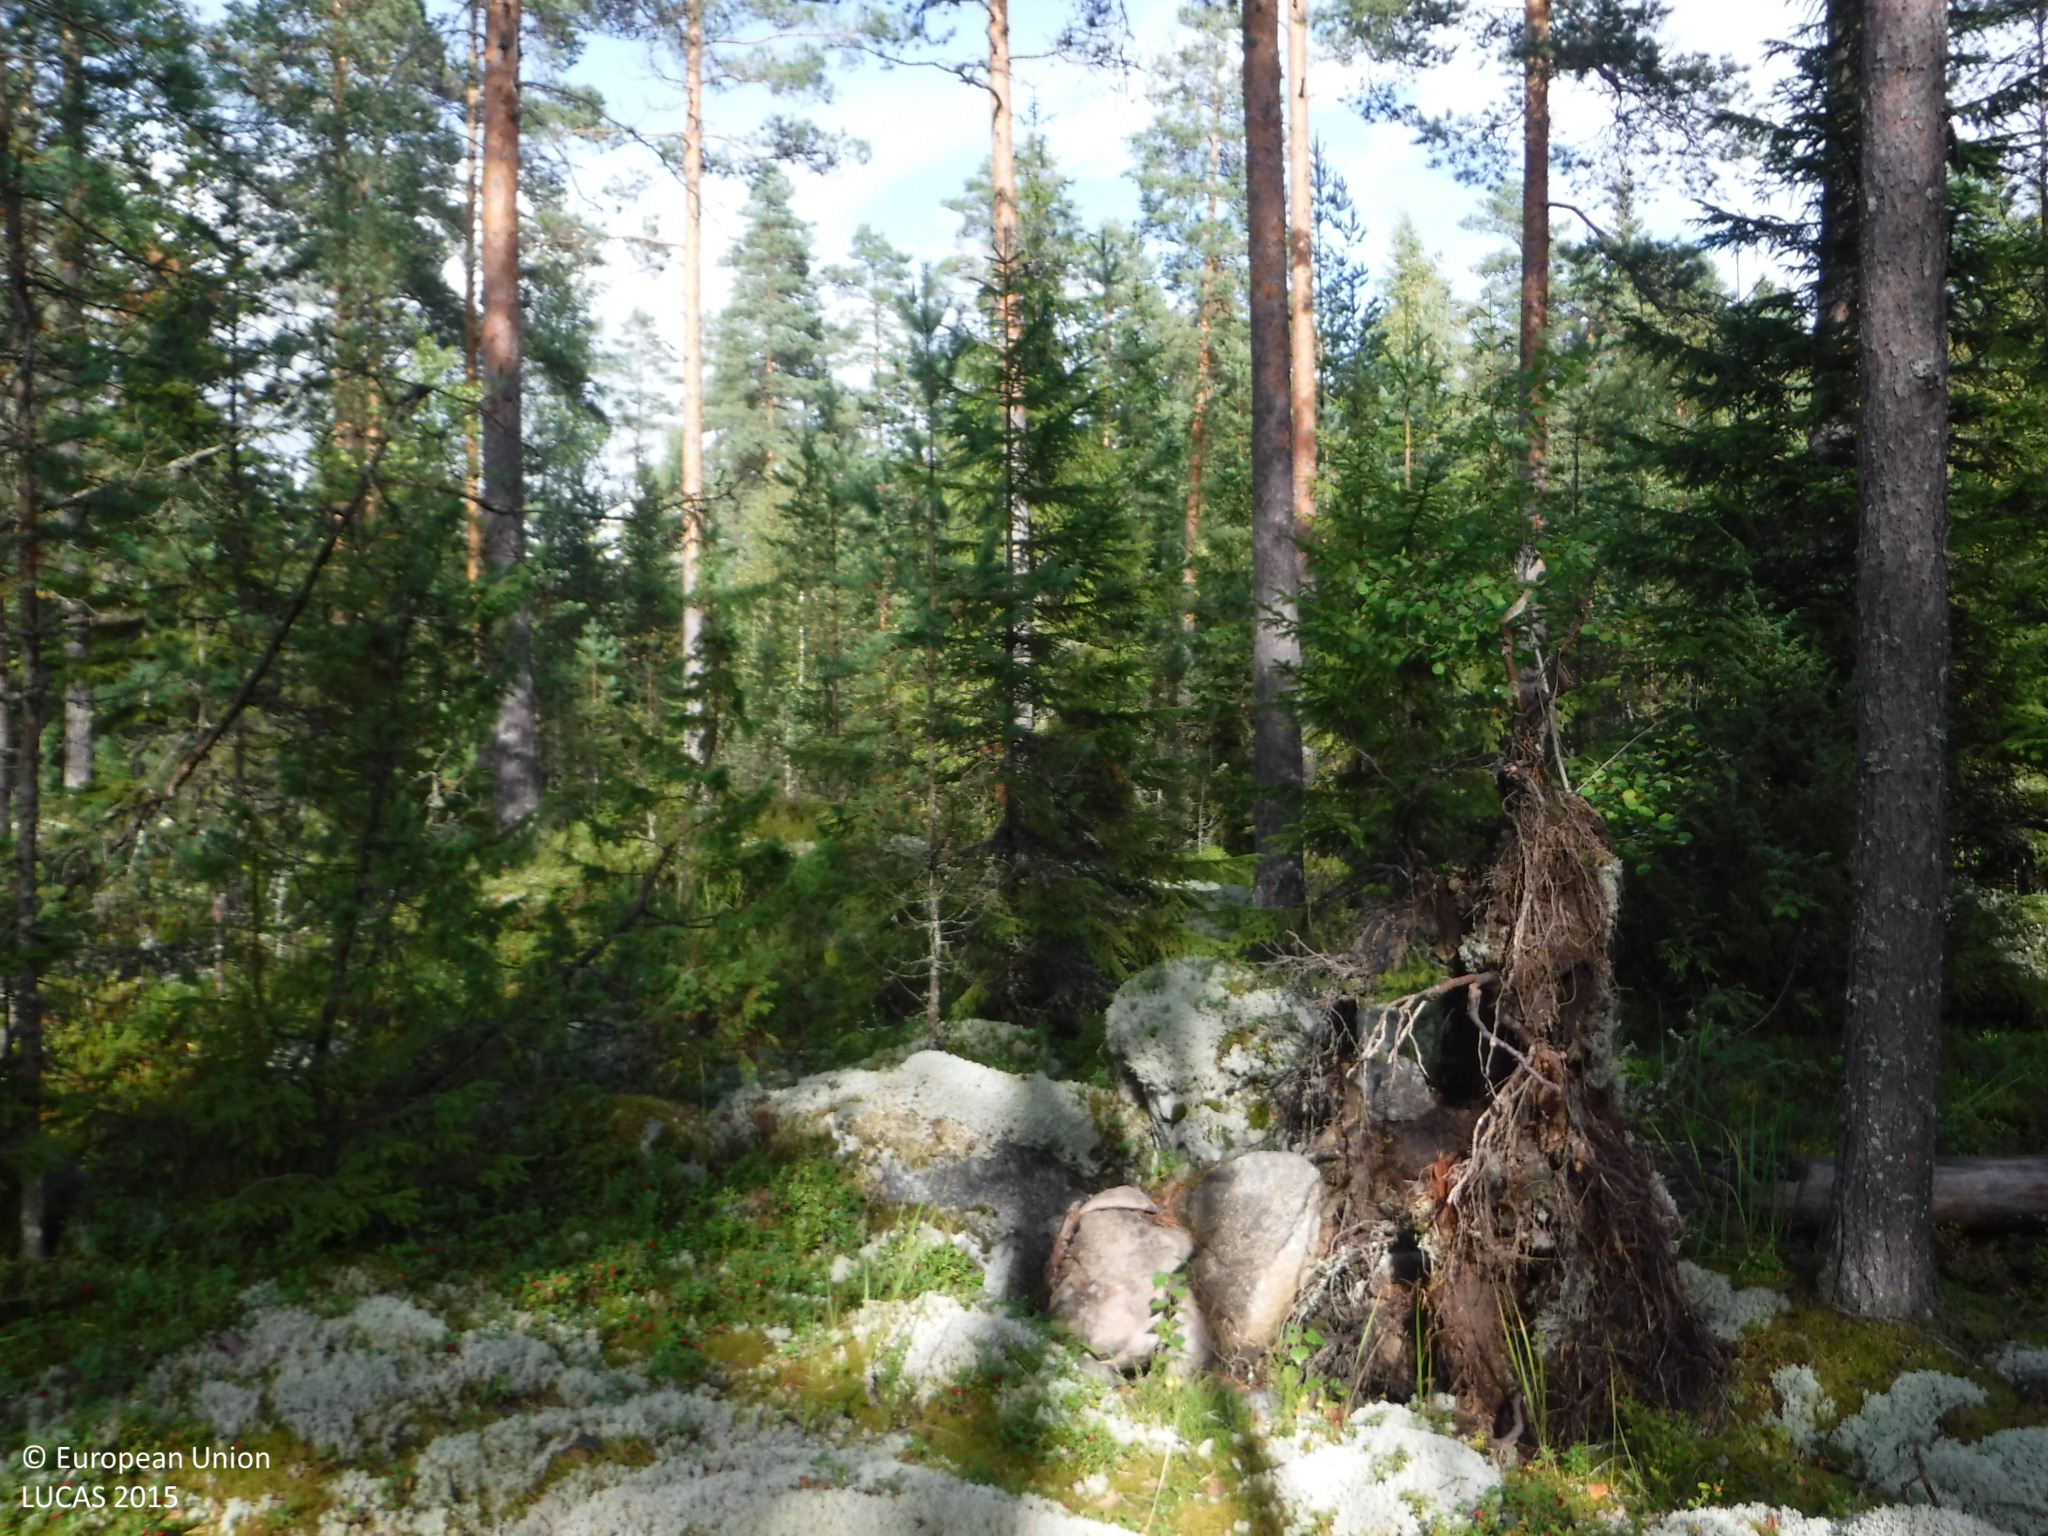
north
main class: Woodland
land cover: Pine dominated coniferous woodland
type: boreal forest
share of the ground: 25 - 50 %
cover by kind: lichens and mosses 45 %, coniferous forest trees 30 %, shrubs 25 %
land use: Forestry
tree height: > 5 m
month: September
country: FI
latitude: 61.3656
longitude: 22.6179
